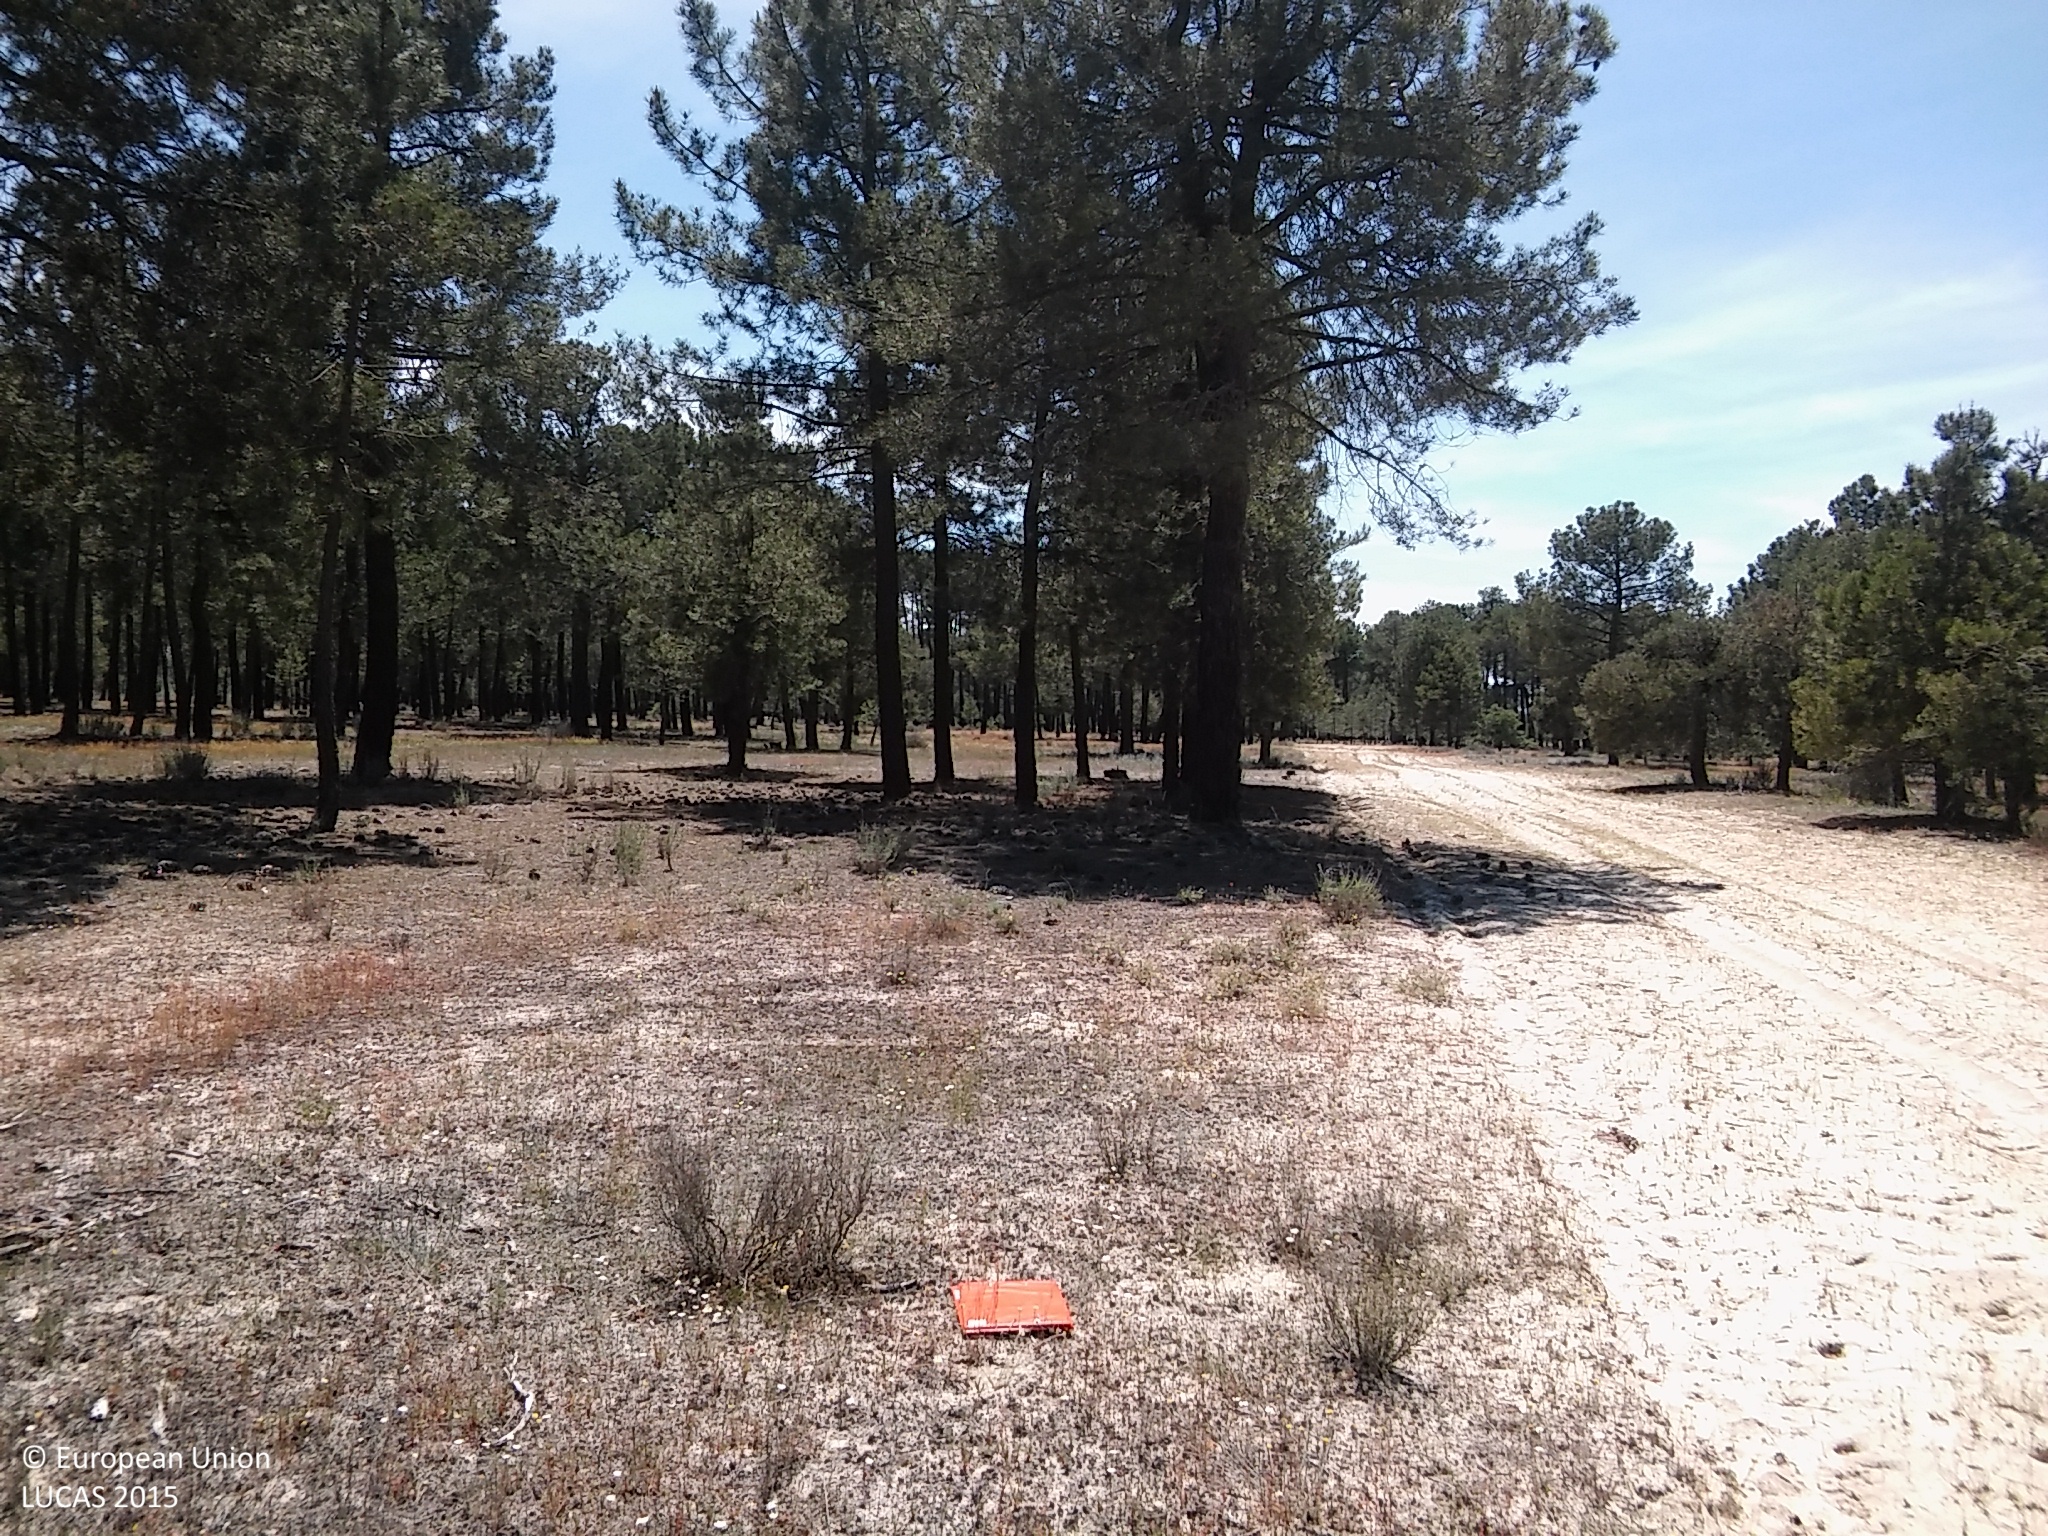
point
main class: Woodland
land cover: Pine dominated coniferous woodland
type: coniferous forest of the mediterranean region
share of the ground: 10 - 25 %
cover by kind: unconsolidated bare surface 65 %, coniferous forest trees 15 %, shrubs 10 %, lichens and mosses 10 %
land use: Forestry
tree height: > 5 m
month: May
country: ES
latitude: 41.3178
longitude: -3.9456
